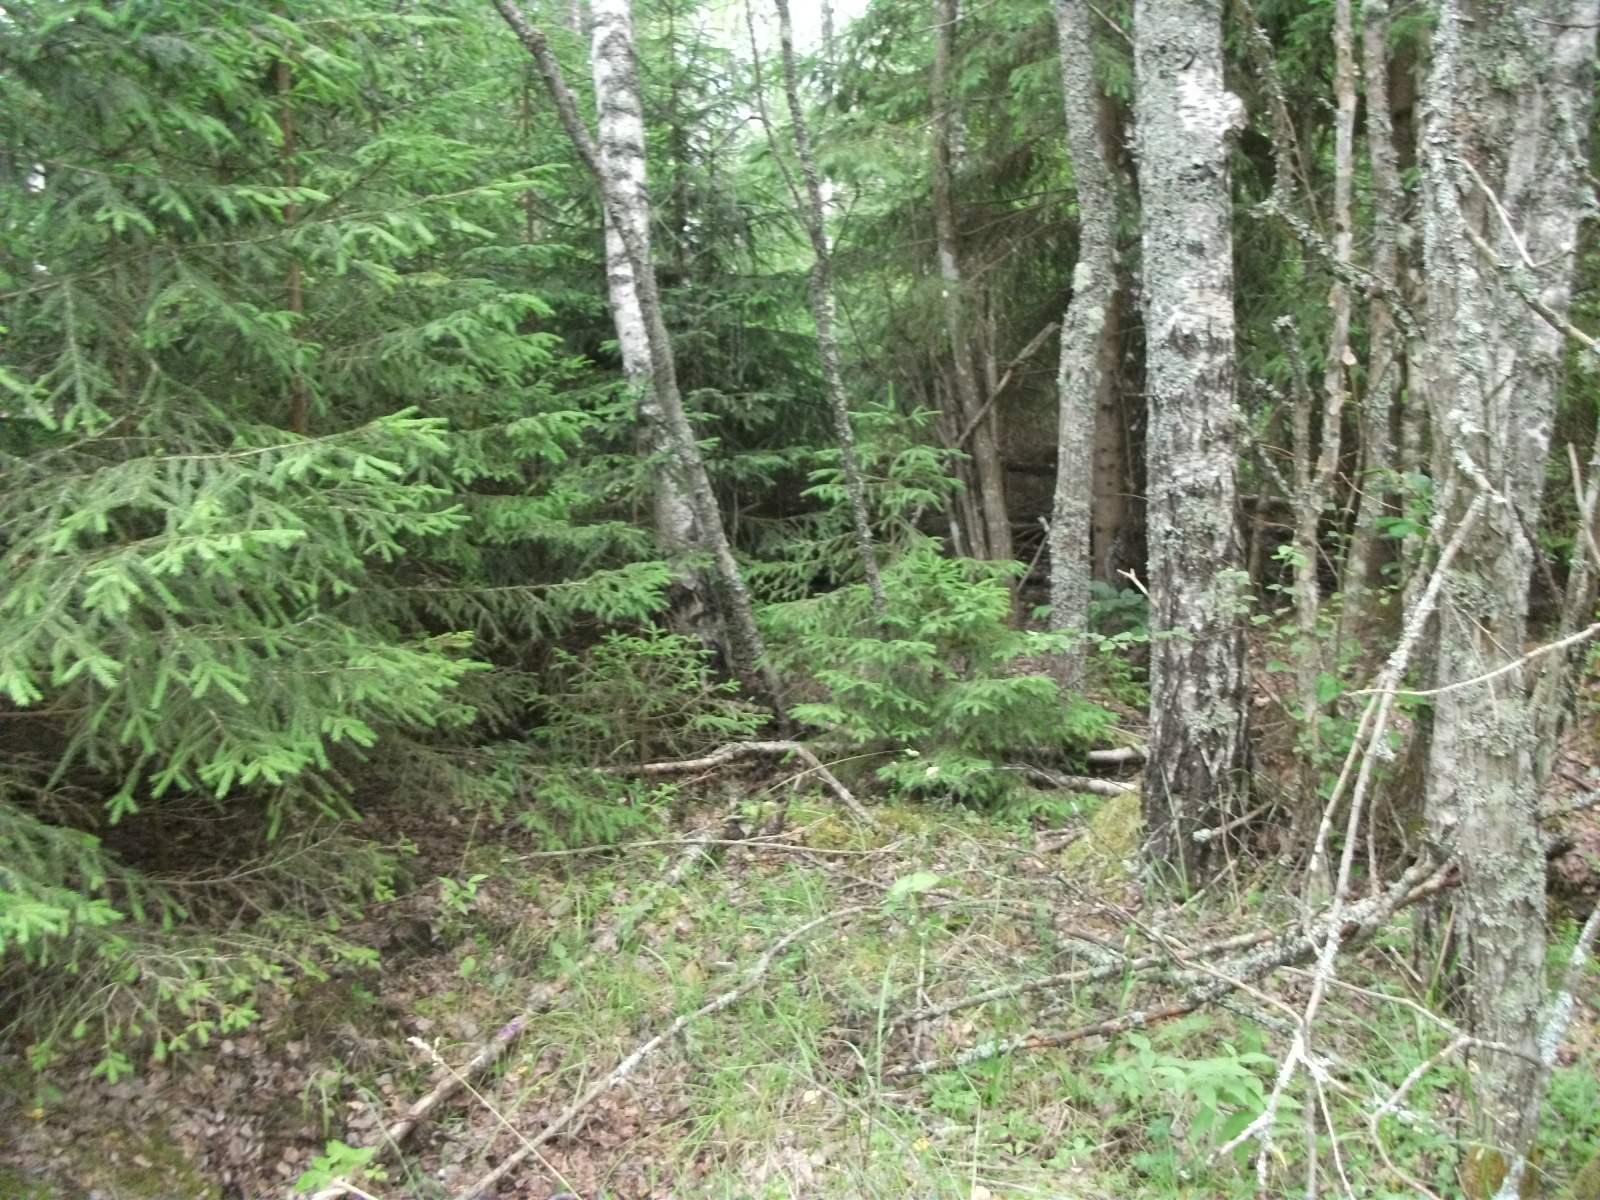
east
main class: Woodland
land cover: Spruce dominated mixed woodland
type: hemiboreal forest and nemoral coniferous forest and mixed broadleaved-coniferous forest
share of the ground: 50 - 75 %
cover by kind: coniferous forest trees 45 %, broadleaved forest trees 25 %, shrubs 10 %, herbaceous plants 10 %, lichens and mosses 10 %
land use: Forestry
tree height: > 5 m
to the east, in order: Spruce dominated mixed woodland; Pine dominated coniferous woodland; Tracks; Other bare soil
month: July
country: LV
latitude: 57.2182
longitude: 26.5566
